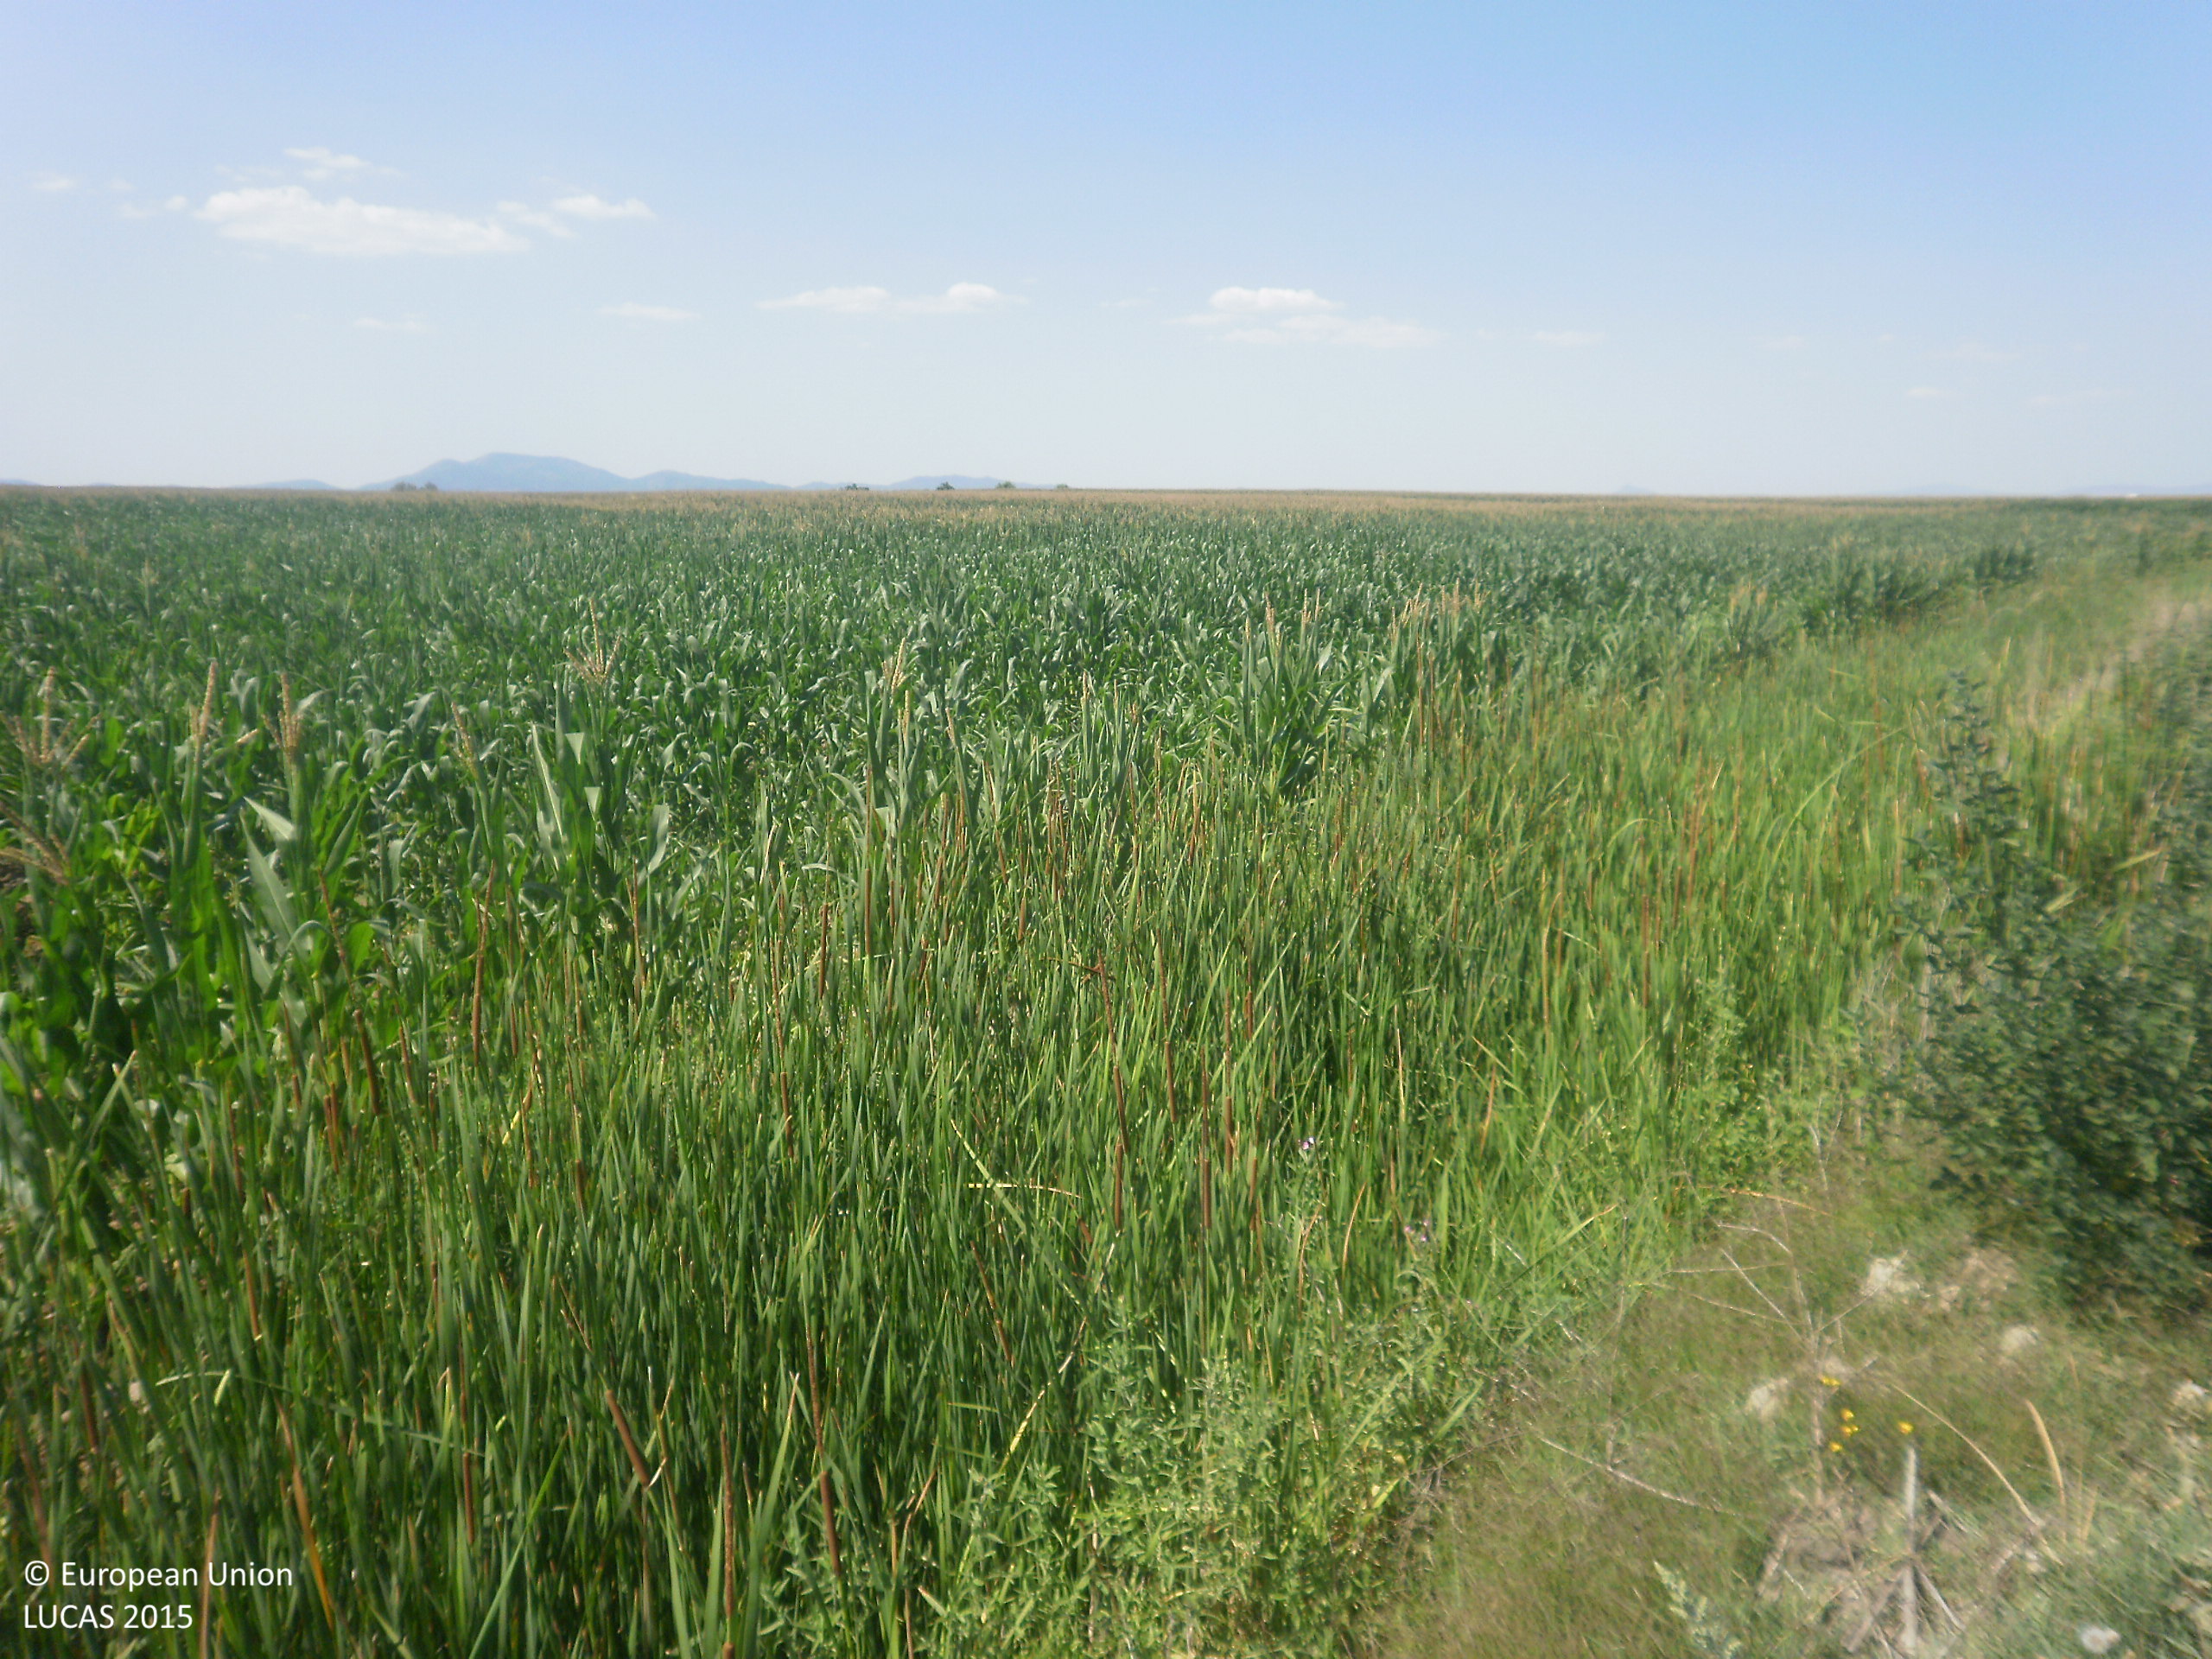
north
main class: Cropland
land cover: Maize
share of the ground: > 75 %
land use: Agriculture (excluding fallow land and kitchen gardens)
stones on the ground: < 10 %
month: June
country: ES
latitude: 39.0569
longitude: -5.9890
